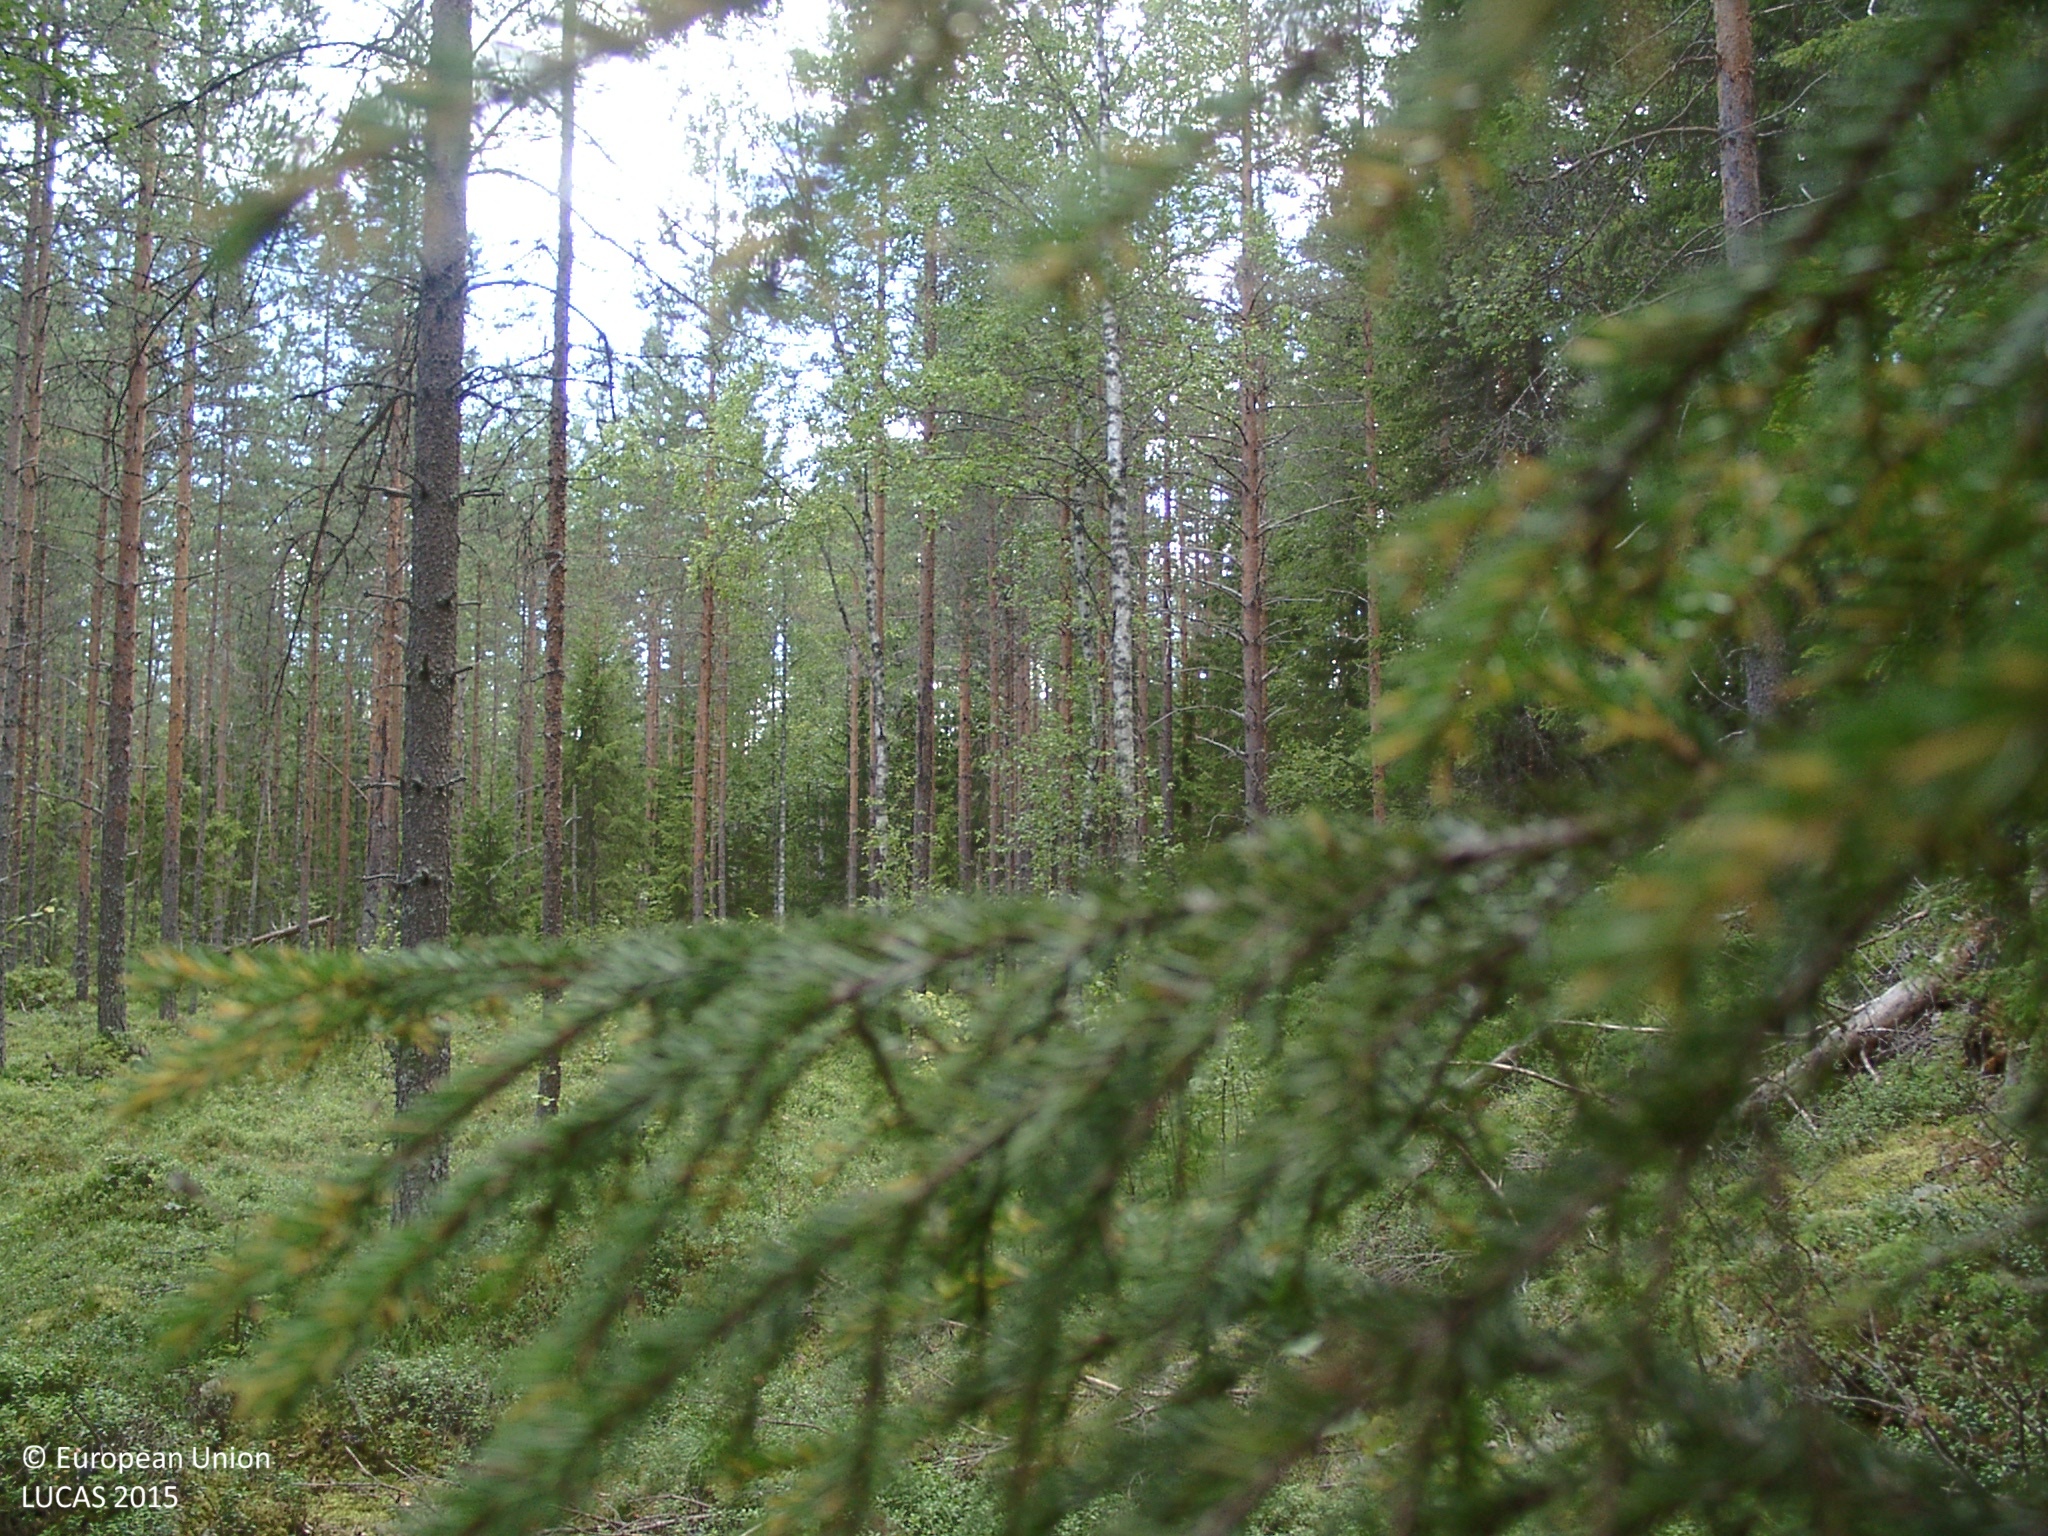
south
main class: Woodland
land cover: Other mixed woodland
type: boreal forest
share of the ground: 50 - 75 %
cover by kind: coniferous forest trees 50 %, broadleaved forest trees 20 %, shrubs 20 %, lichens and mosses 10 %
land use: Forestry
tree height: > 5 m
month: August
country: FI
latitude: 62.3935
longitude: 25.4908
